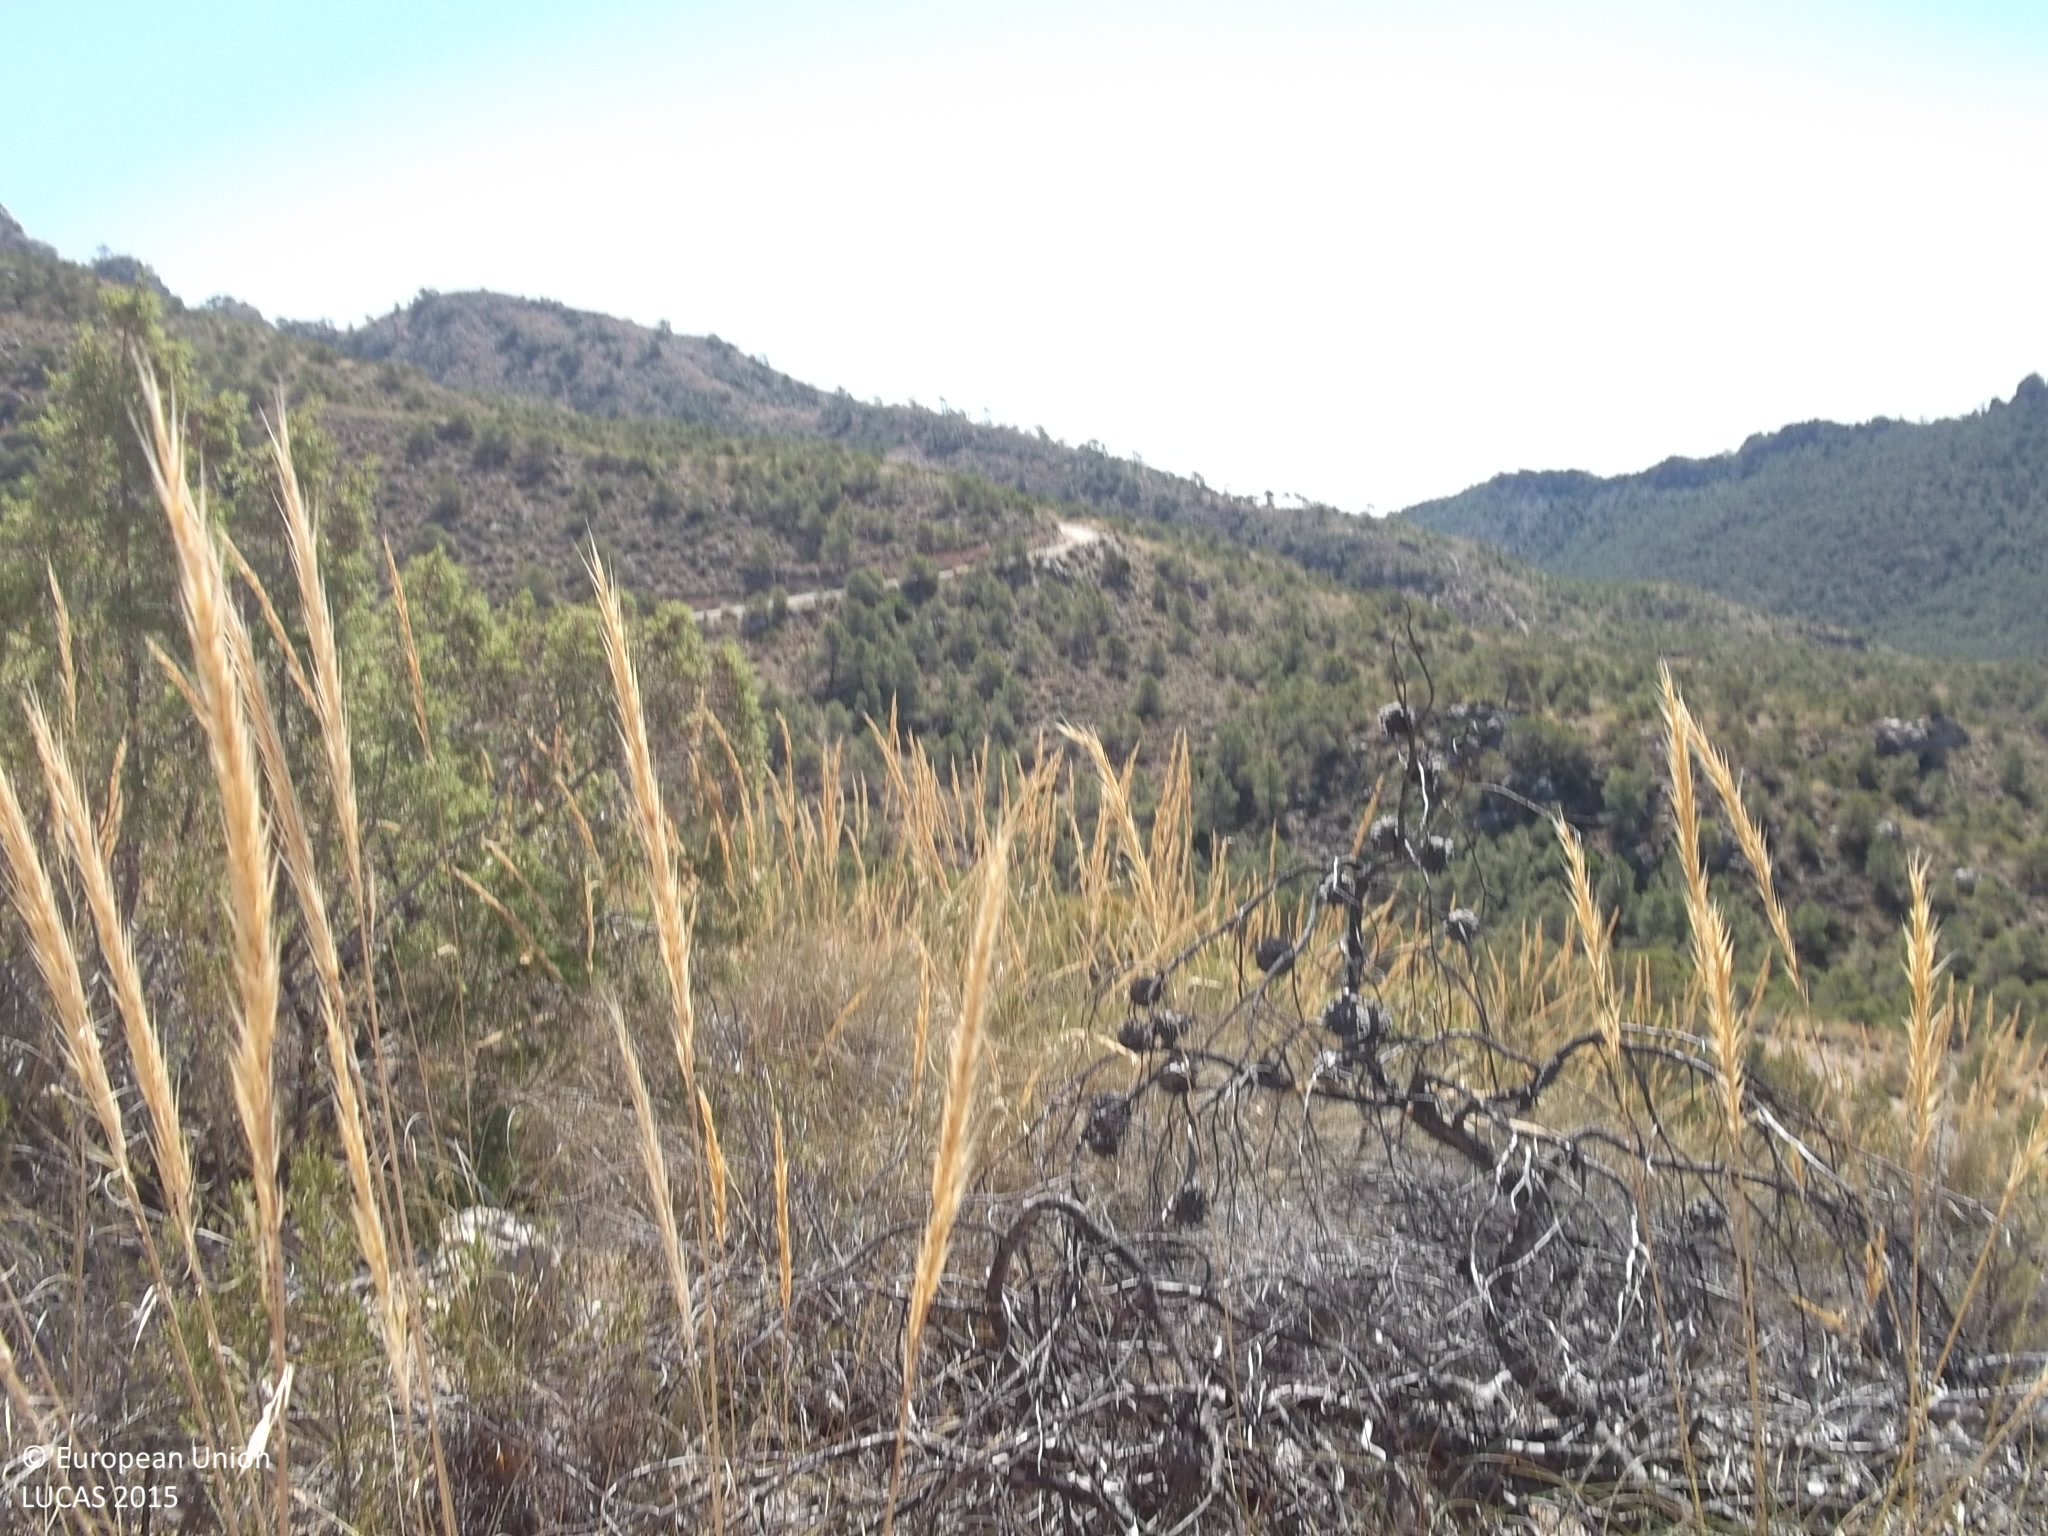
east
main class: Woodland
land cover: Pine dominated coniferous woodland
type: coniferous forest of the mediterranean region
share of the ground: 10 - 25 %
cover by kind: shrubs 30 %, herbaceous plants 30 %, coniferous forest trees 20 %, consolidated bare surface 20 %
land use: Forestry
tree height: < 5 m
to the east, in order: Pine dominated coniferous woodland; Tracks; Pine dominated coniferous woodland
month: June
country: ES
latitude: 38.1863
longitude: -1.4620
